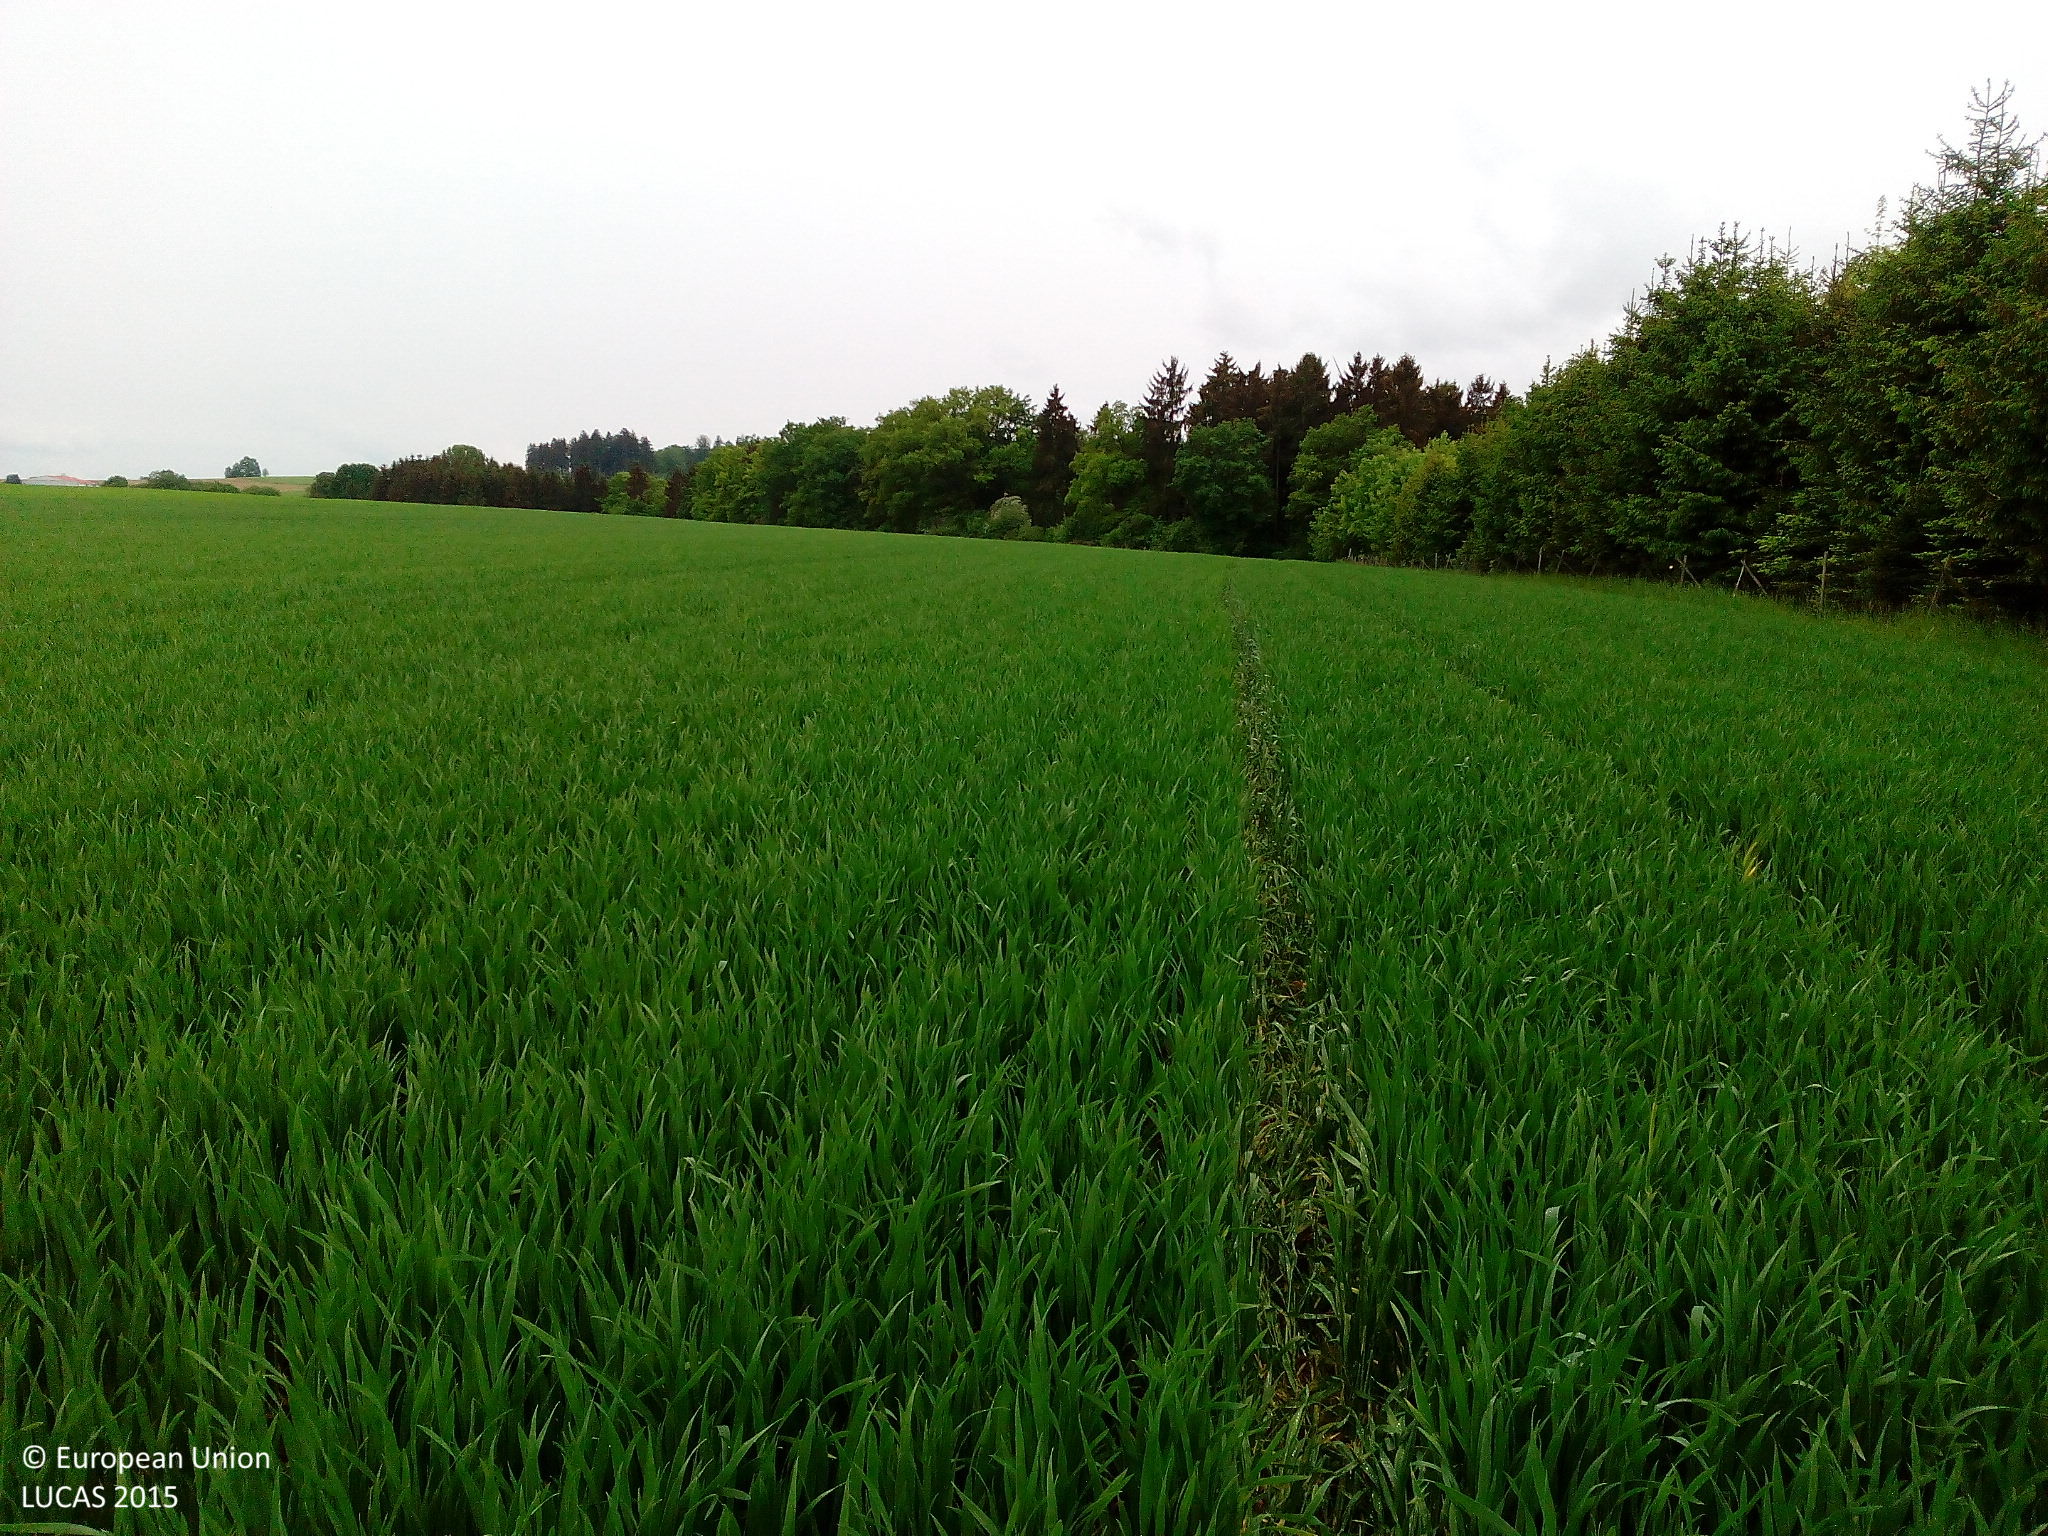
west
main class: Cropland
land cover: Common wheat
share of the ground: > 75 %
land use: Agriculture (excluding fallow land and kitchen gardens)
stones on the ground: < 10 %
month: May
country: DE
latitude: 49.2739
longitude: 11.5801
